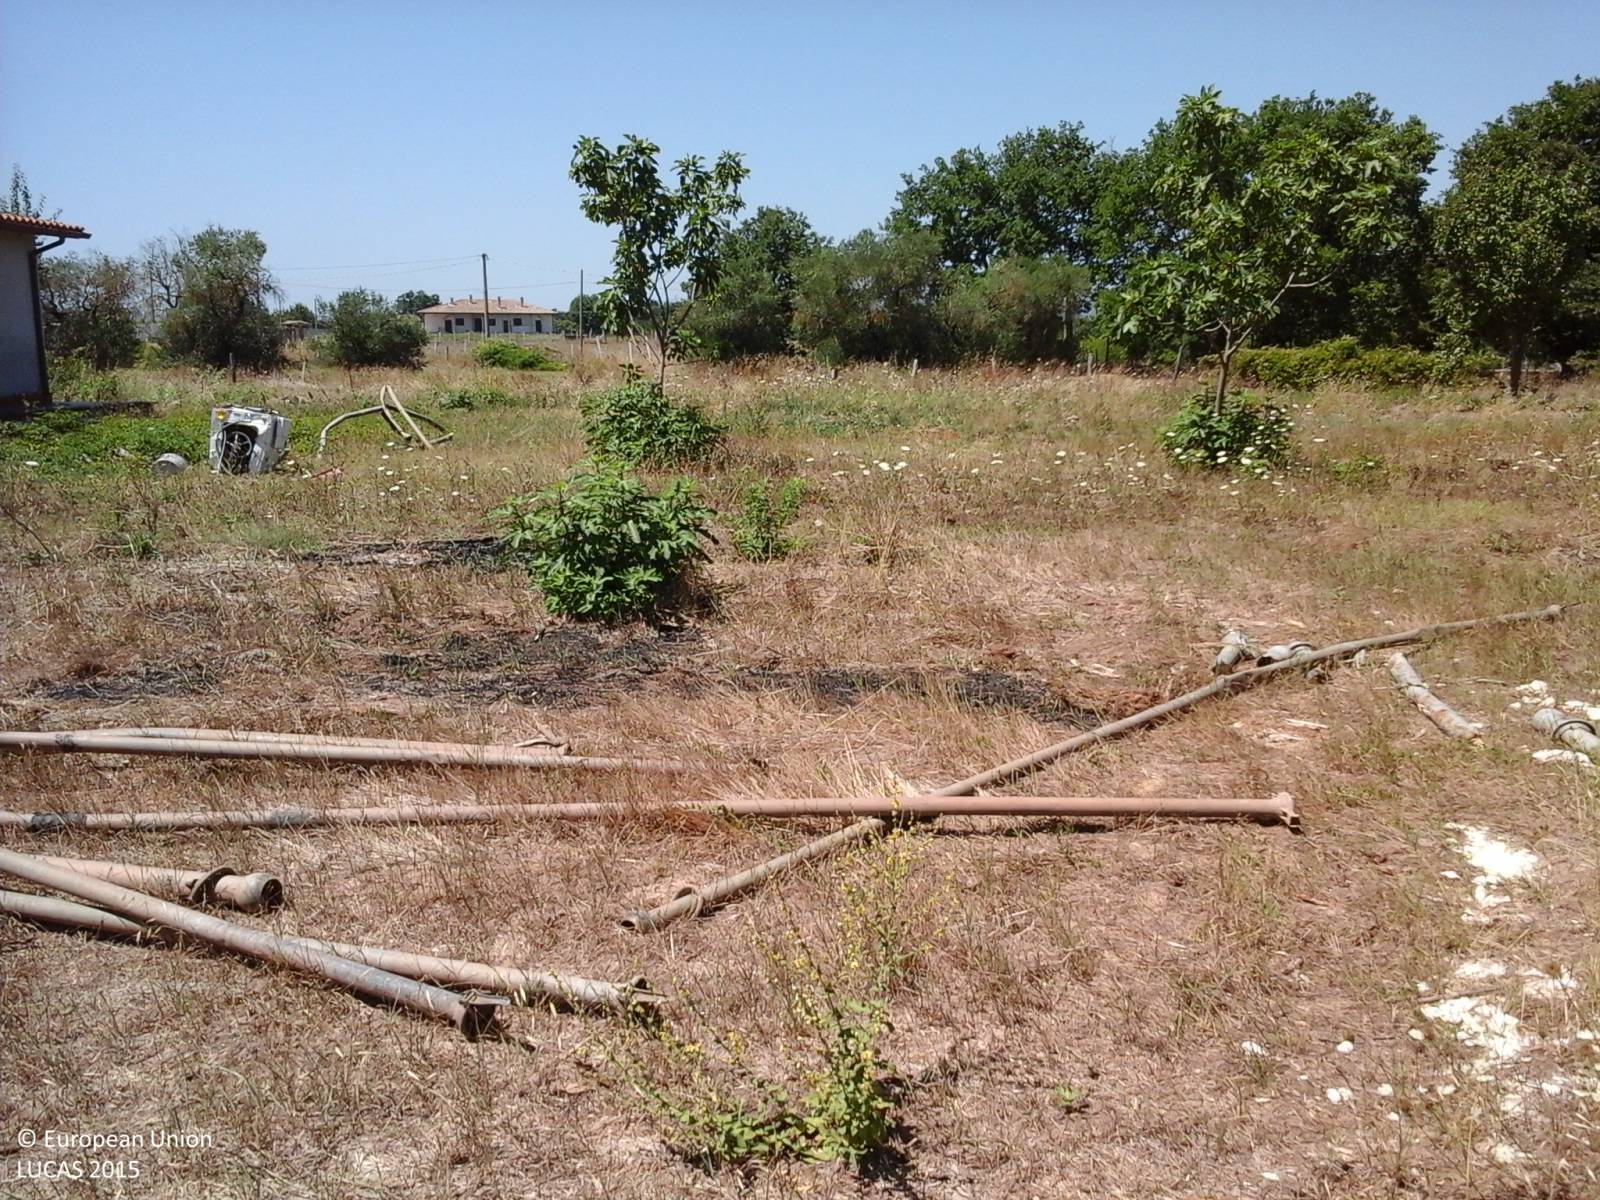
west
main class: Grassland
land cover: Grassland with sparse tree/shrub cover
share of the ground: > 75 %
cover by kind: herbaceous plants 95 %, broadleaved forest trees 5 %
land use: Abandoned areas
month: July
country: IT
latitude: 42.2477
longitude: 12.3310
